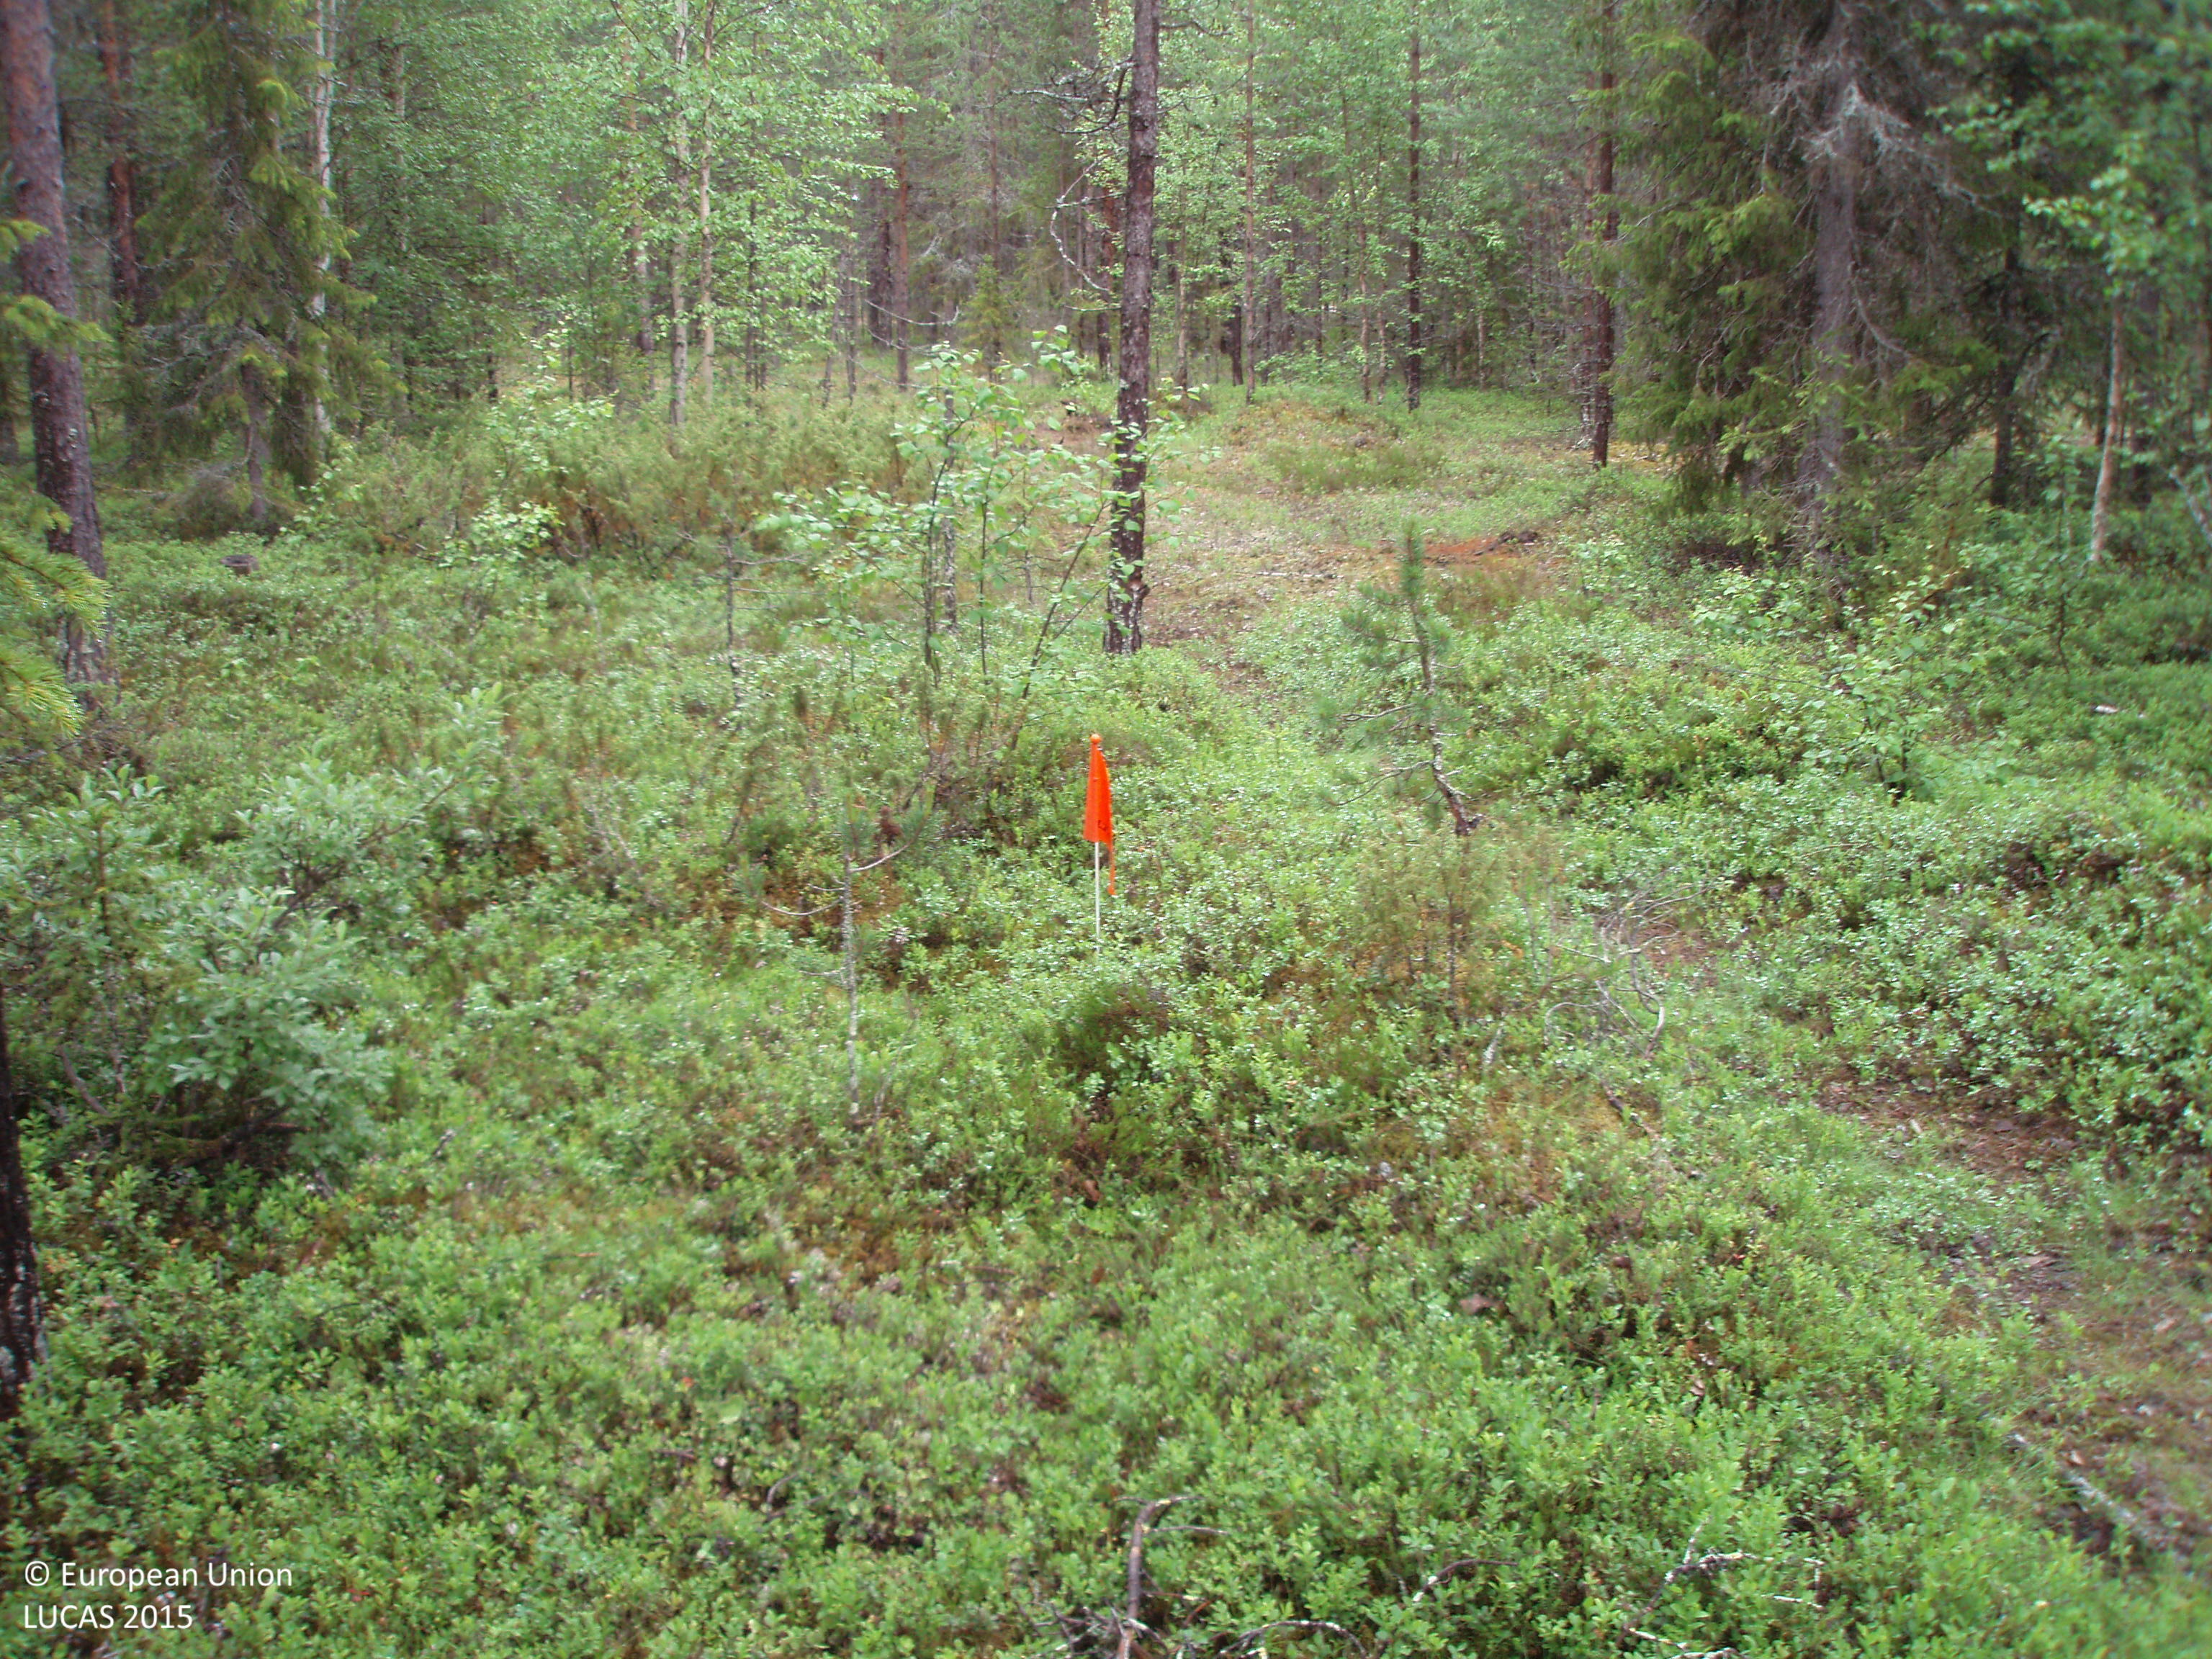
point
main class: Woodland
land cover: Pine dominated mixed woodland
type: boreal forest
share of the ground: > 75 %
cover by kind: coniferous forest trees 60 %, broadleaved forest trees 25 %, shrubs 15 %
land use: Forestry
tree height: > 5 m
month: July
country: FI
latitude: 67.0908
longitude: 28.8638
